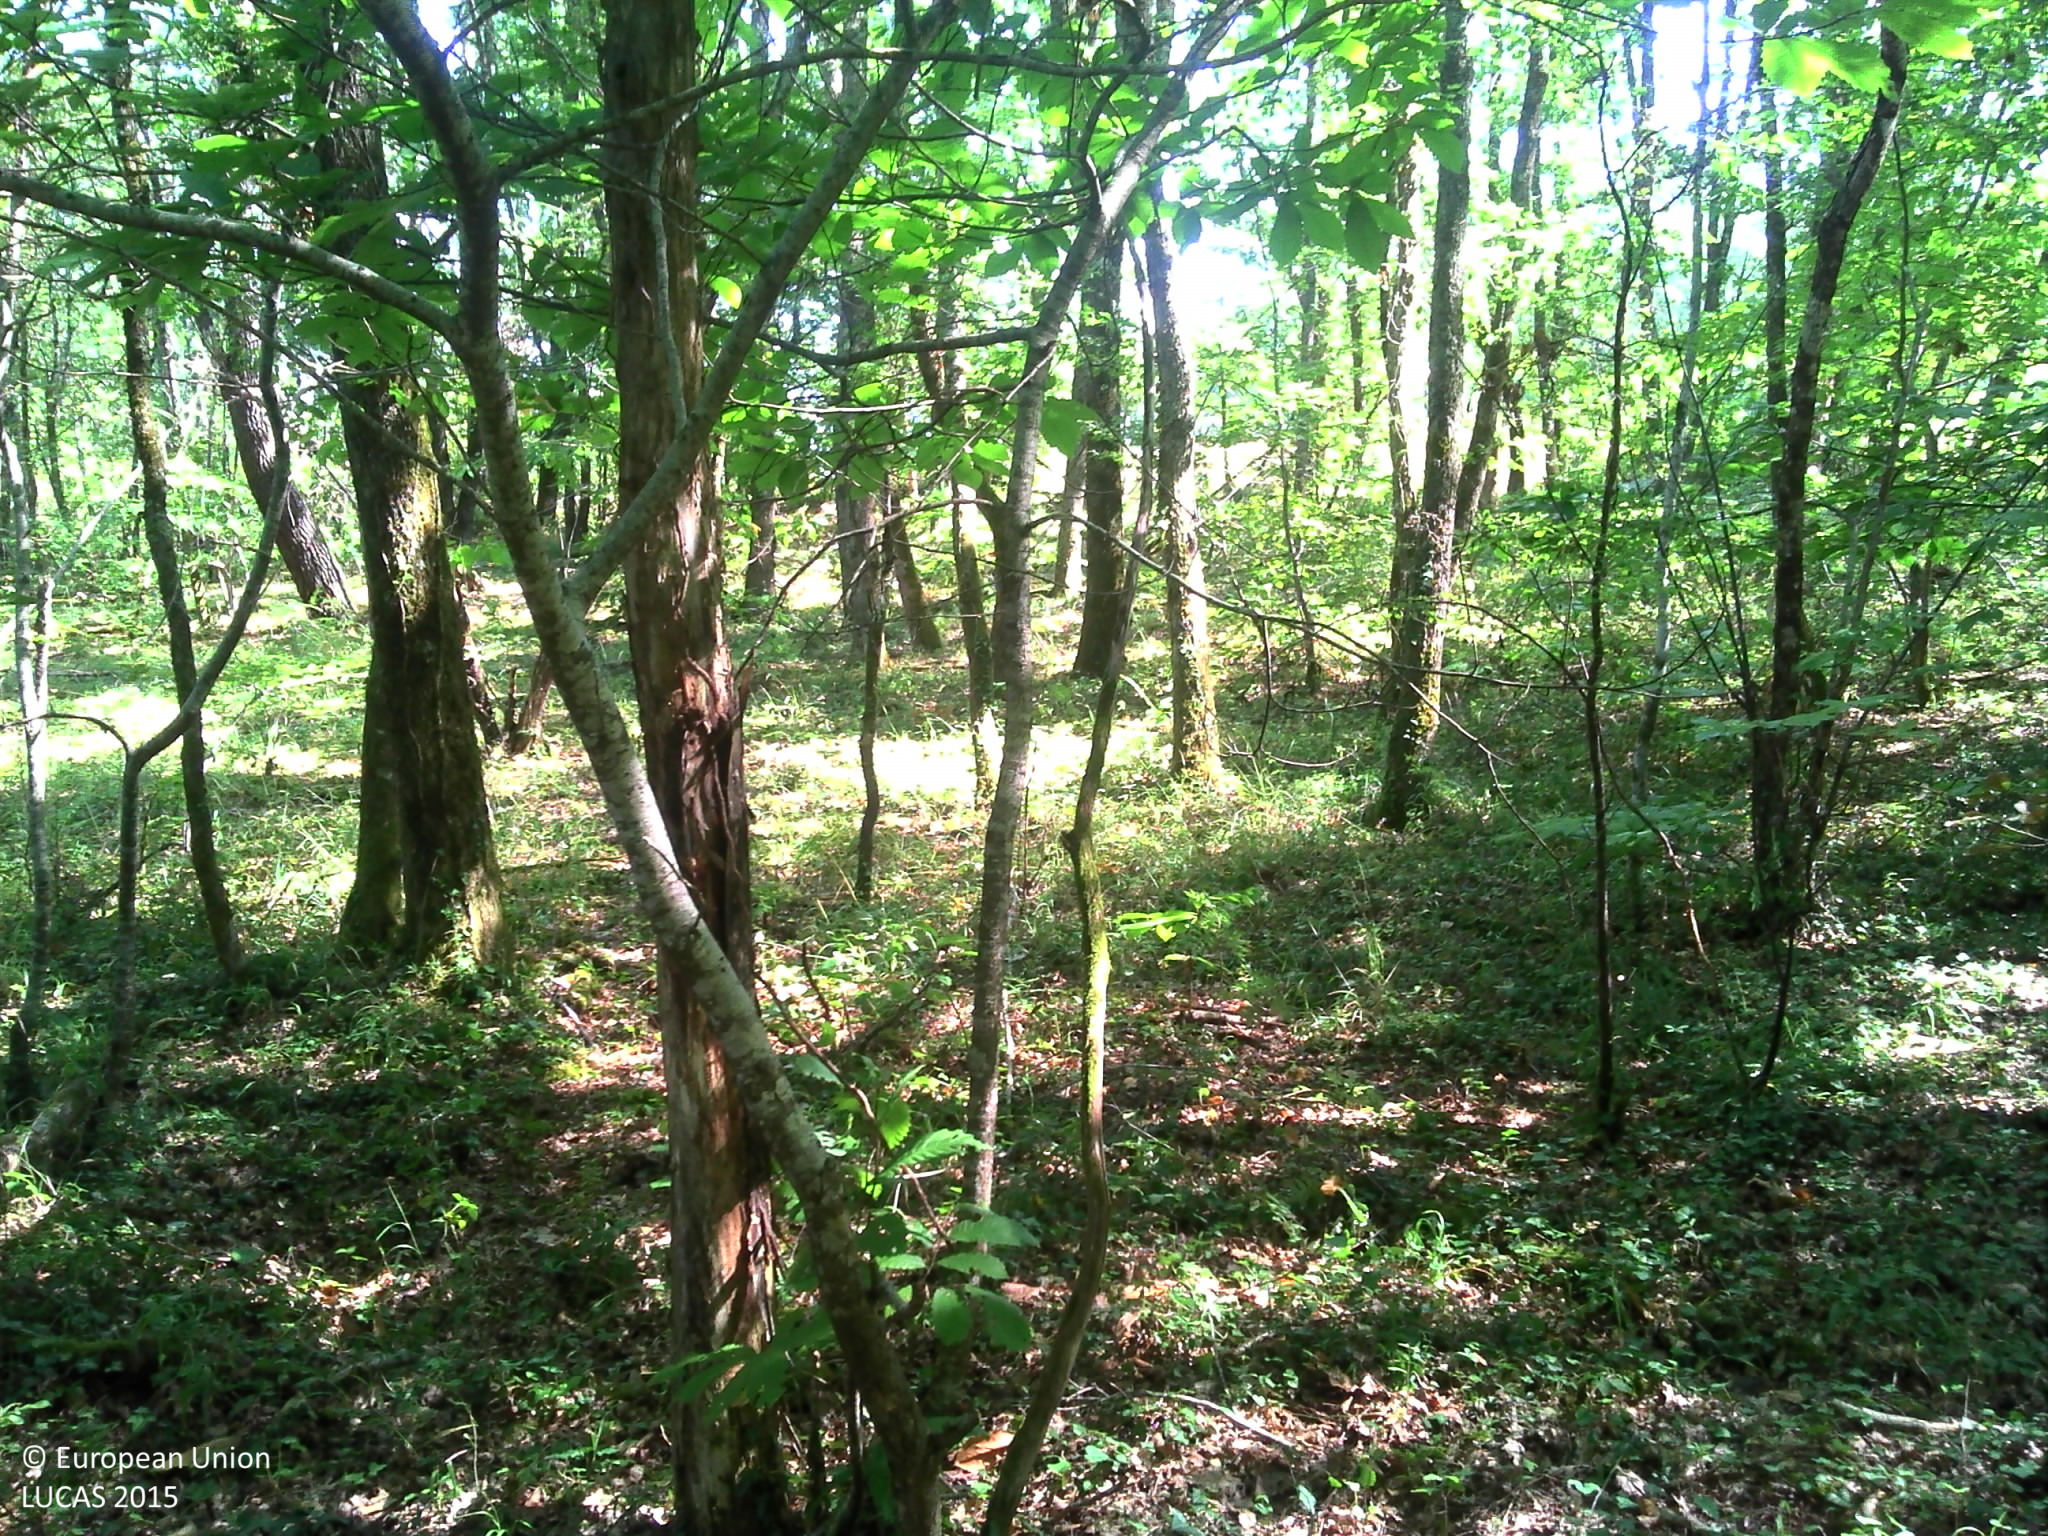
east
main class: Woodland
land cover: Broadleaved woodland
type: thermophilous deciduous forest
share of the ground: > 75 %
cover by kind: broadleaved forest trees 90 %, herbaceous plants 10 %
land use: Forestry
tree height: > 5 m
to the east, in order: Broadleaved woodland; Pine dominated mixed woodland; Grassland without tree/shrub cover; Broadleaved woodland; Dry stone walls; Broadleaved woodland; Dry stone walls; Broadleaved woodland; Dry stone walls; Broadleaved woodland
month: August
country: FR
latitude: 44.5424
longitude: 1.2493
